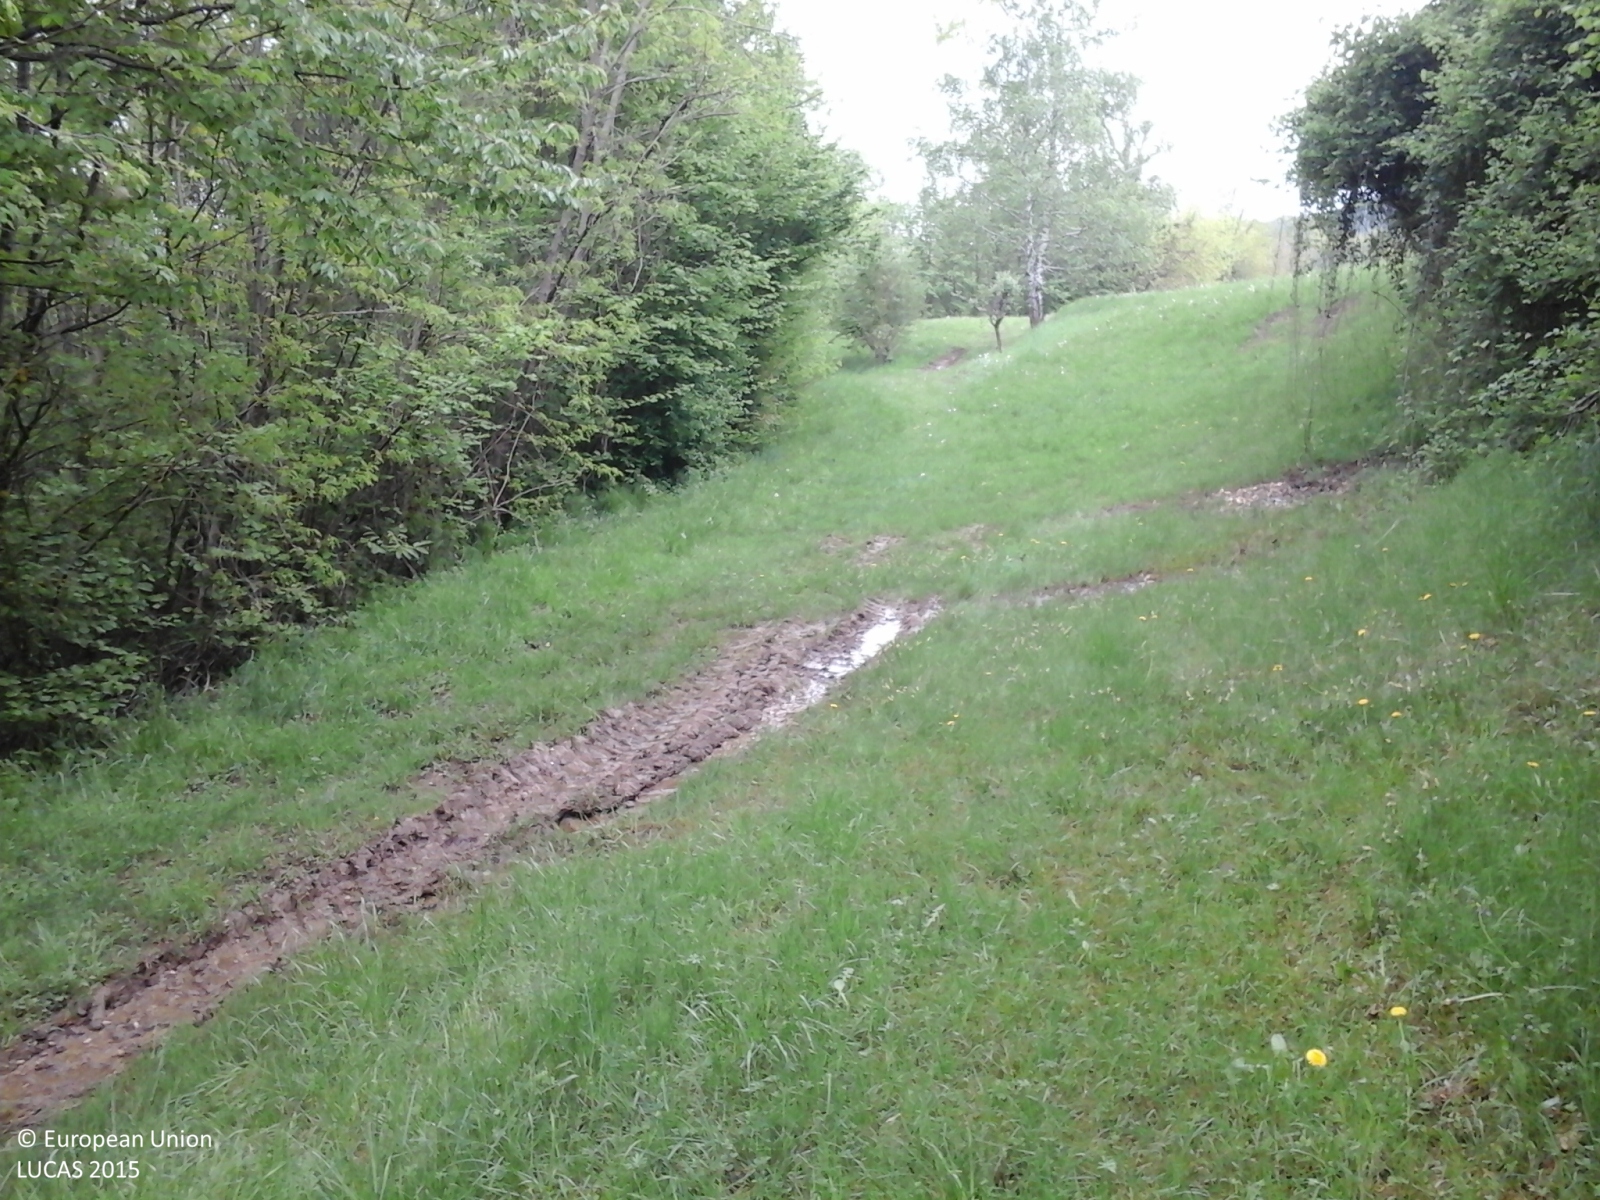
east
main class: Woodland
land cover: Broadleaved woodland
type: thermophilous deciduous forest
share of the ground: > 75 %
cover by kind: broadleaved forest trees 100 %
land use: Forestry
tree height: > 5 m
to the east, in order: Broadleaved woodland; Grassland without tree/shrub cover; Broadleaved woodland
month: April
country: IT
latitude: 45.9686
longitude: 12.1780
